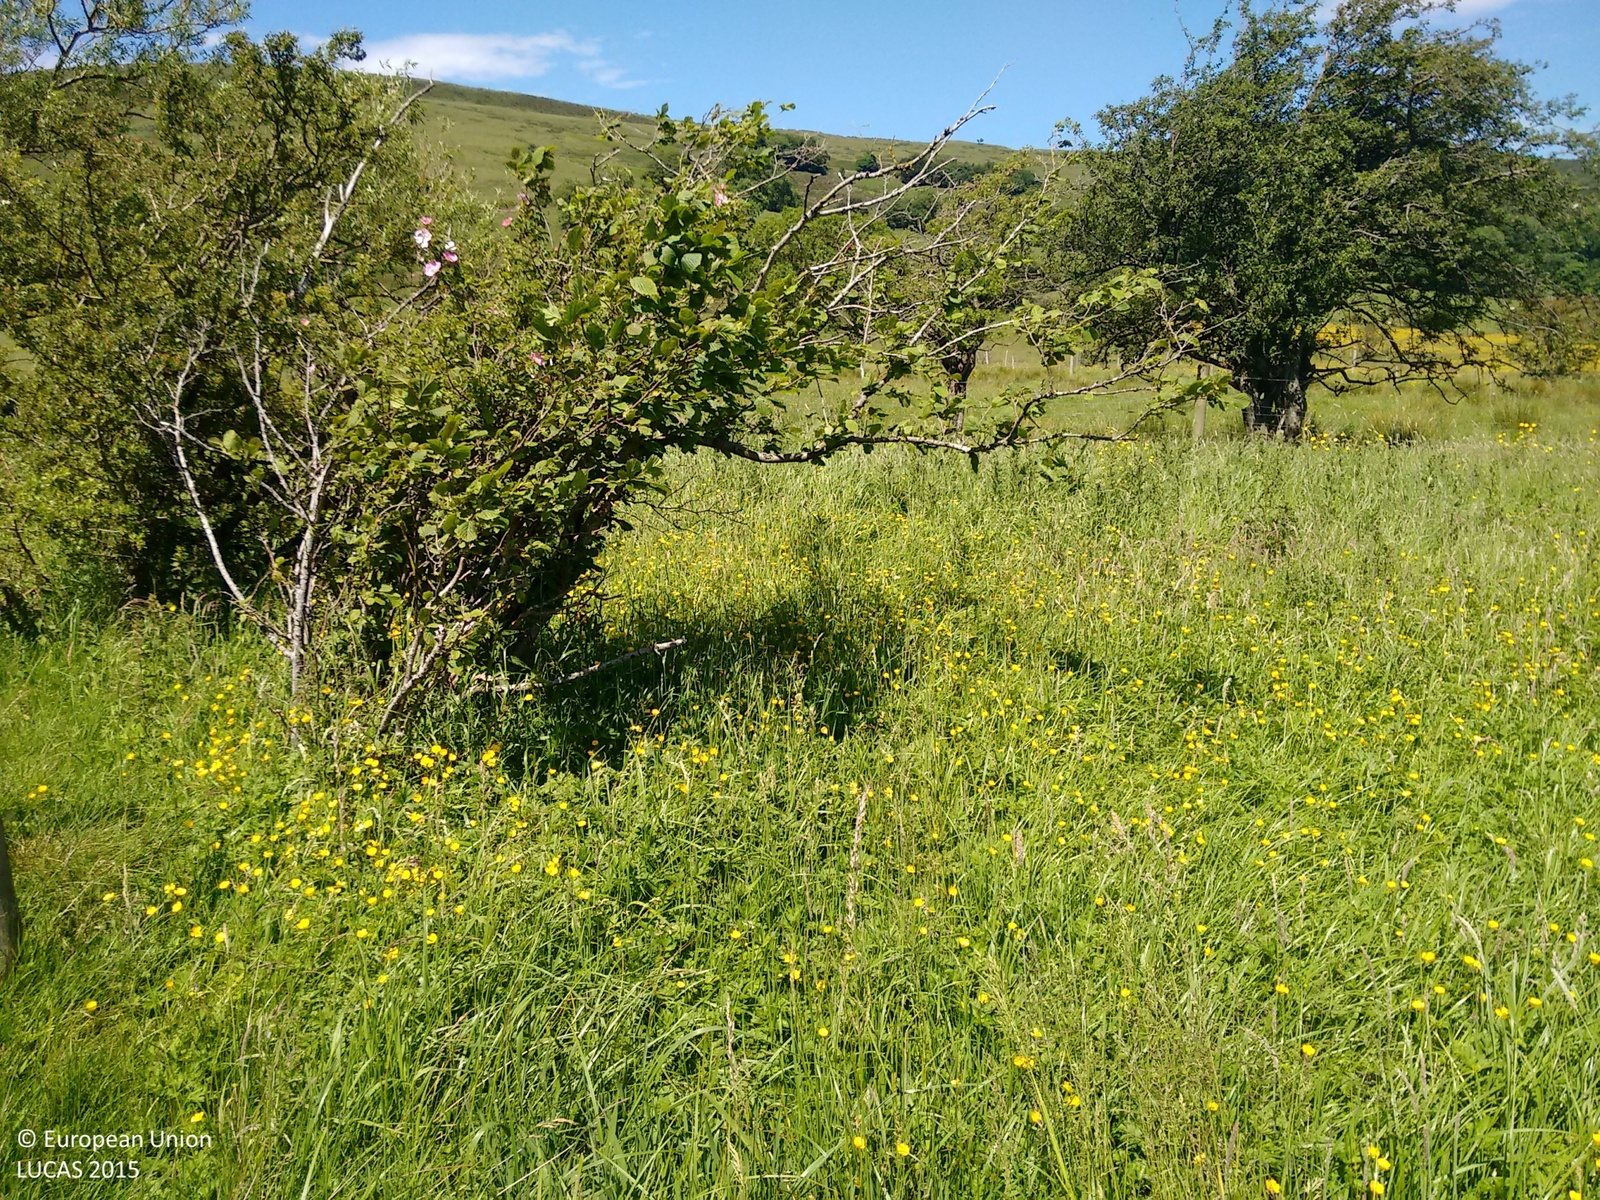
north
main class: Grassland
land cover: Grassland without tree/shrub cover
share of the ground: > 75 %
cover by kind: herbaceous plants 100 %
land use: Agriculture (excluding fallow land and kitchen gardens)
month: June
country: GB
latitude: 53.3510
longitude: -1.7872
